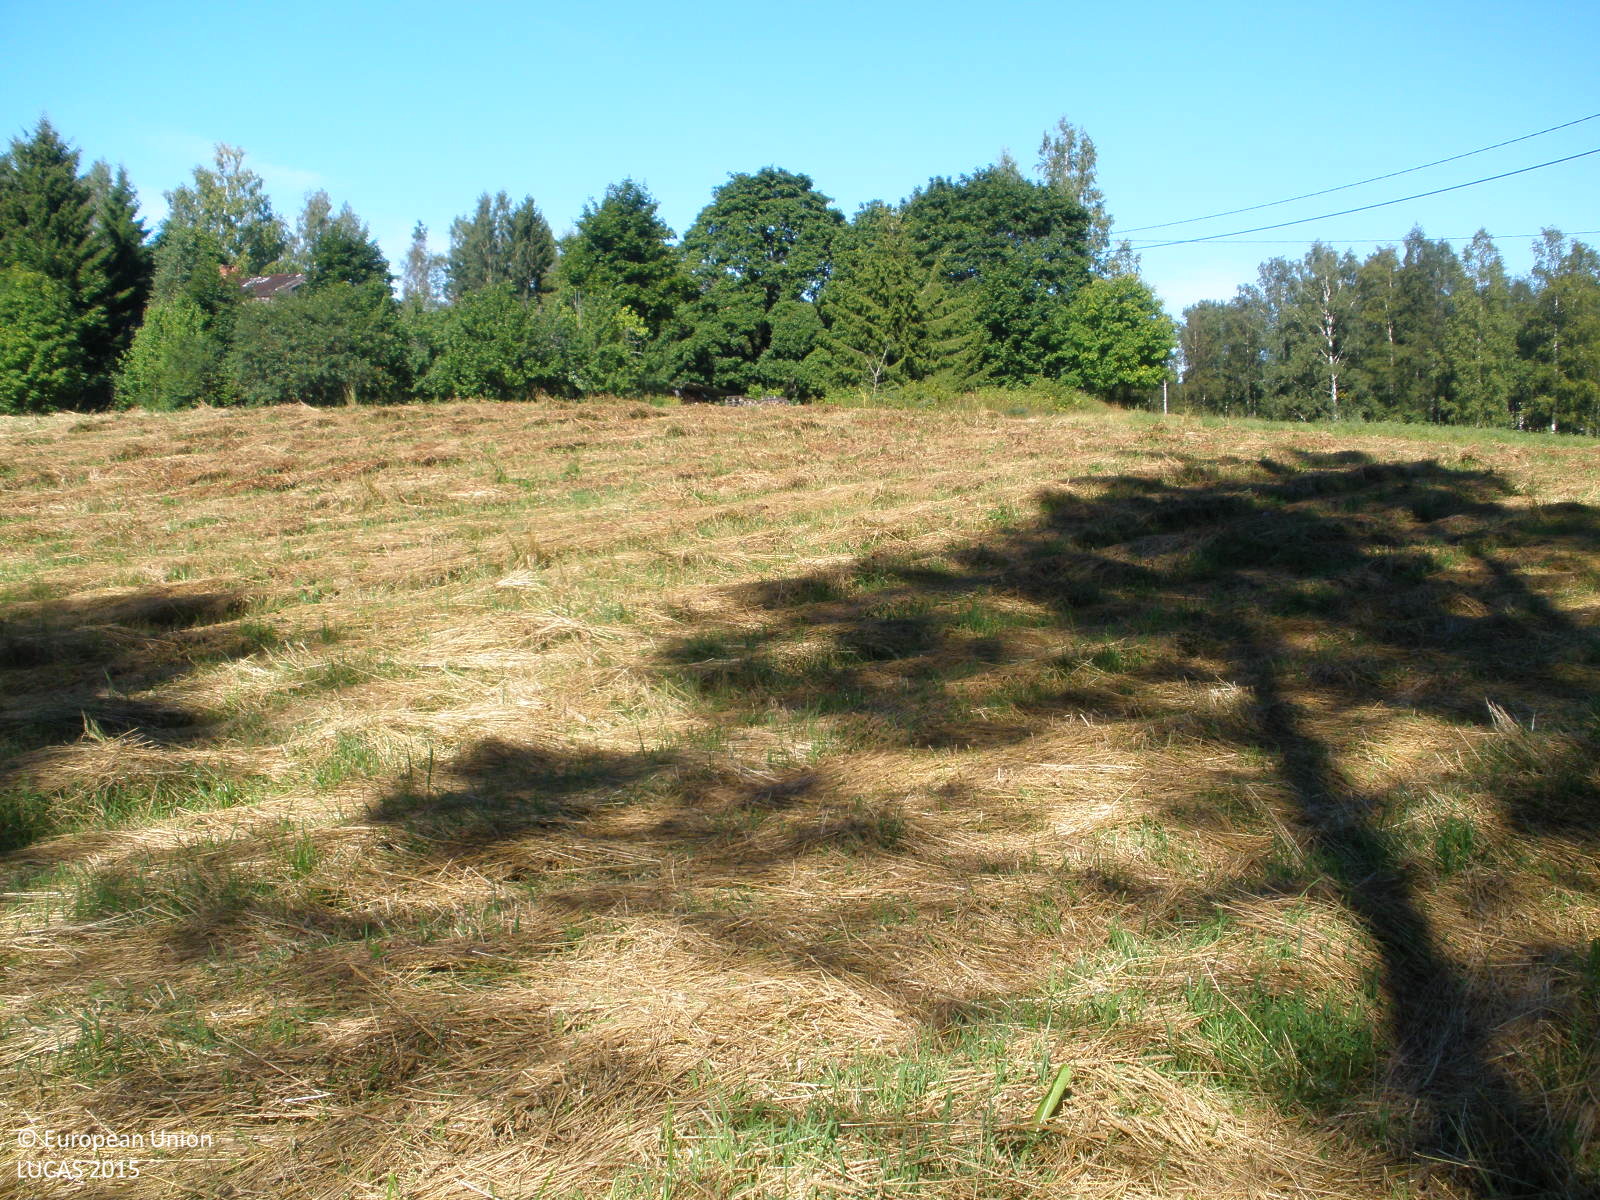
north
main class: Cropland
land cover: Mixed cereals for fodder
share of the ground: 25 - 50 %
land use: Agriculture (excluding fallow land and kitchen gardens)
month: August
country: FI
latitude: 60.6002
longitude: 23.9553
